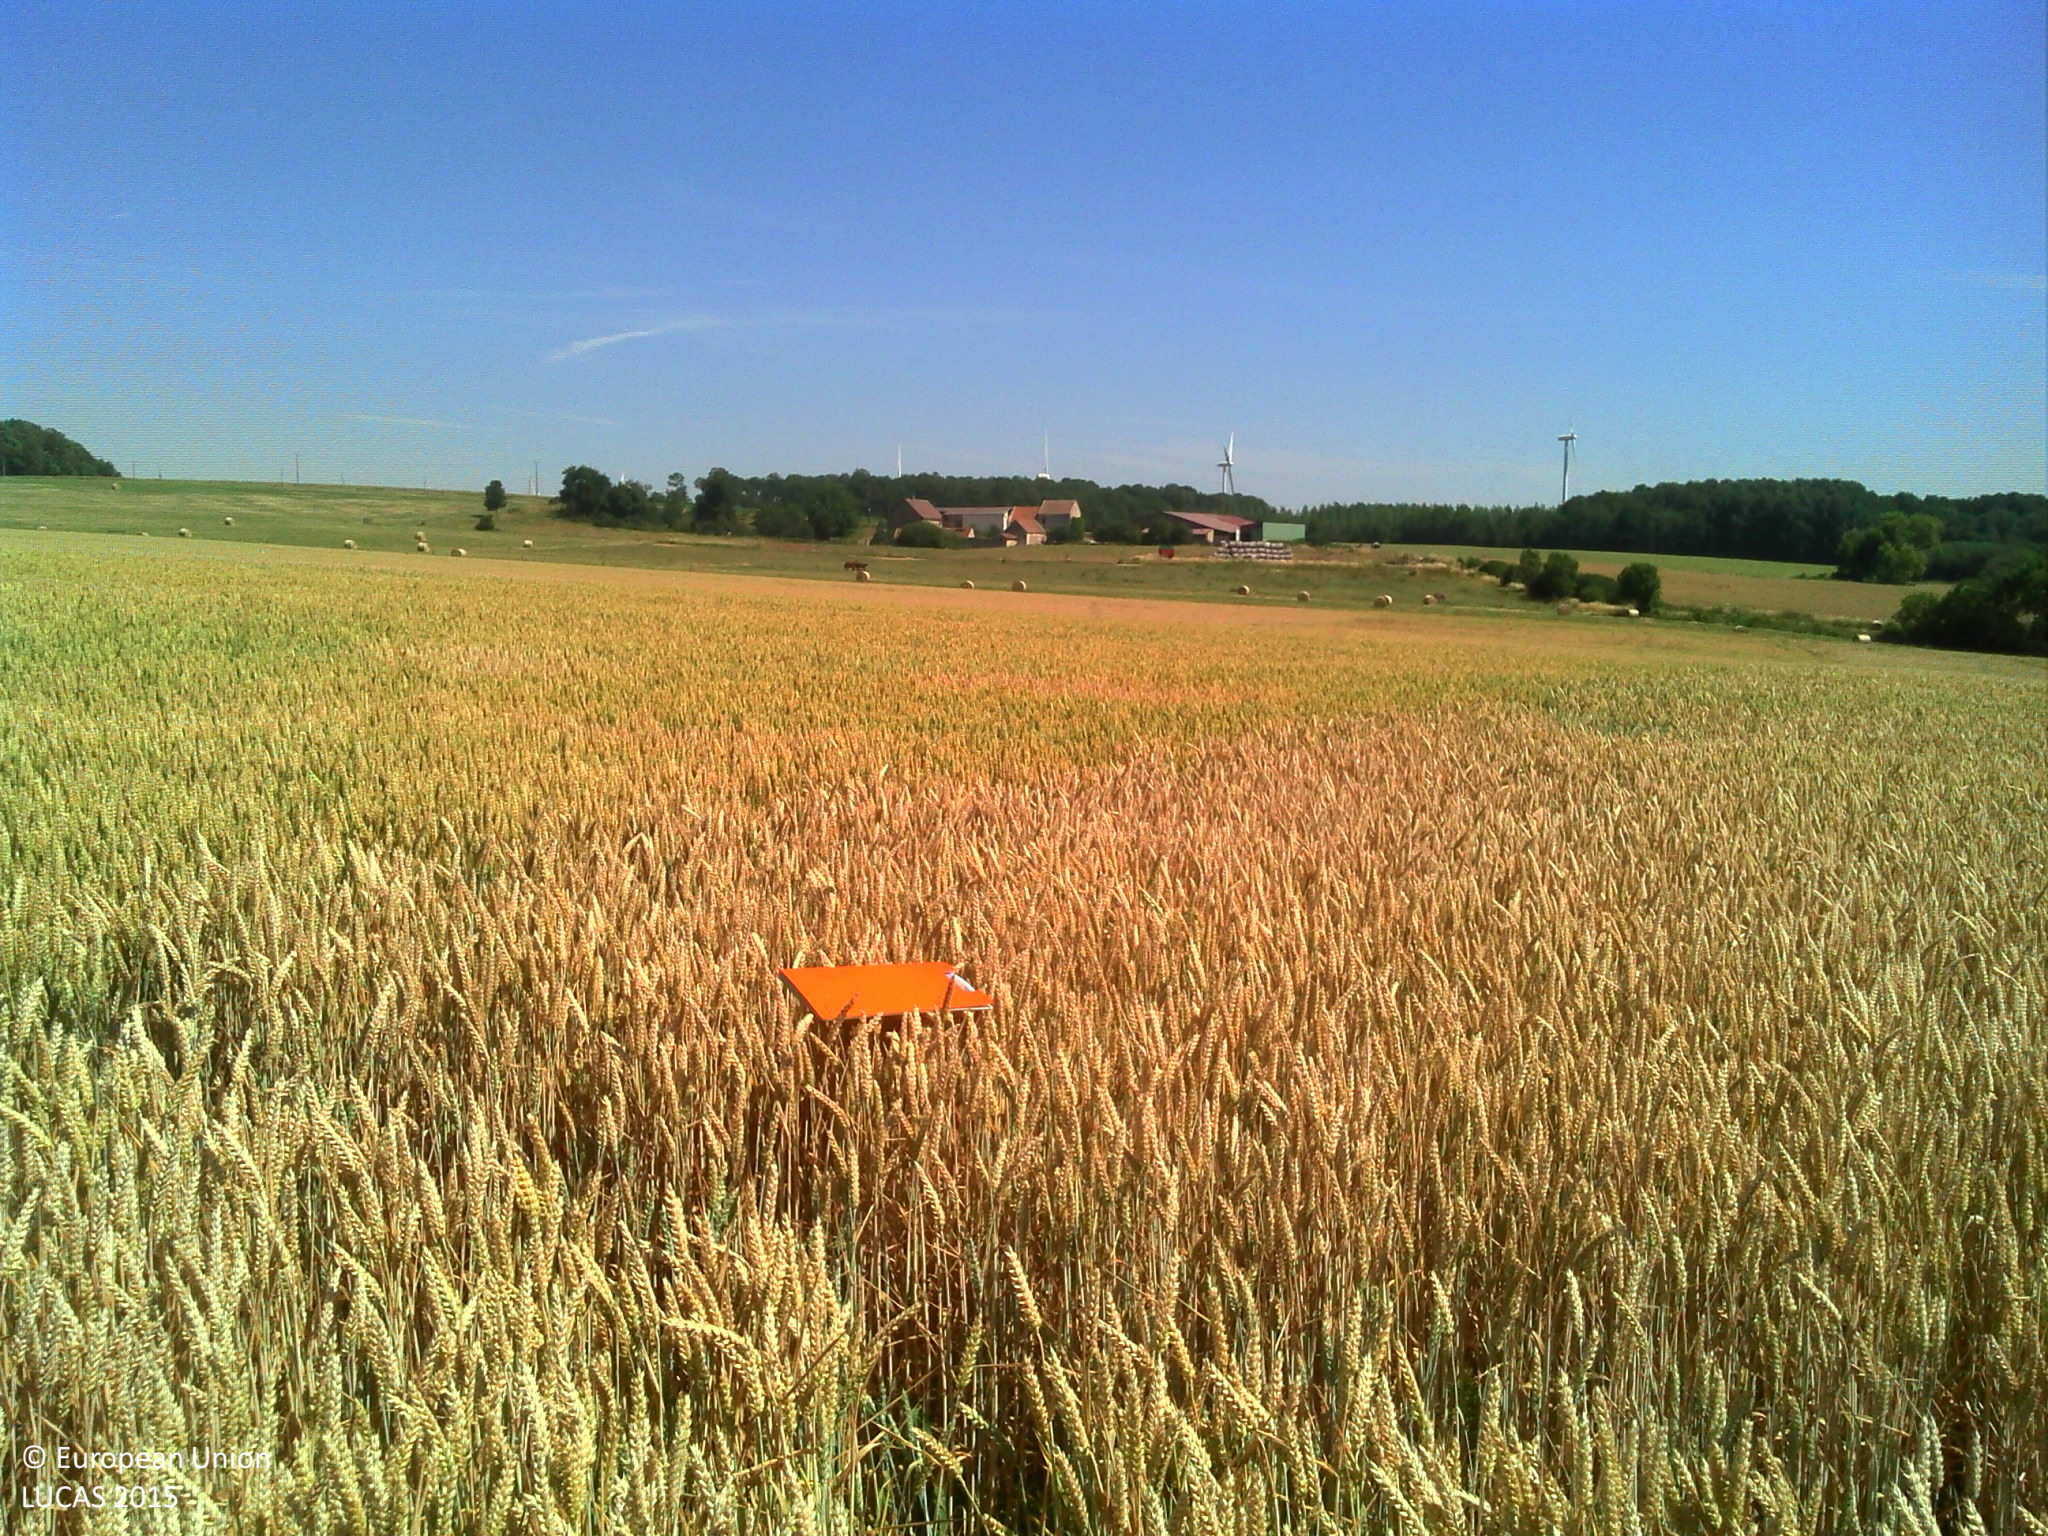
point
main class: Cropland
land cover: Common wheat
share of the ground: > 75 %
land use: Agriculture (excluding fallow land and kitchen gardens)
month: July
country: FR
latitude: 48.9951
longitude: 3.3091
